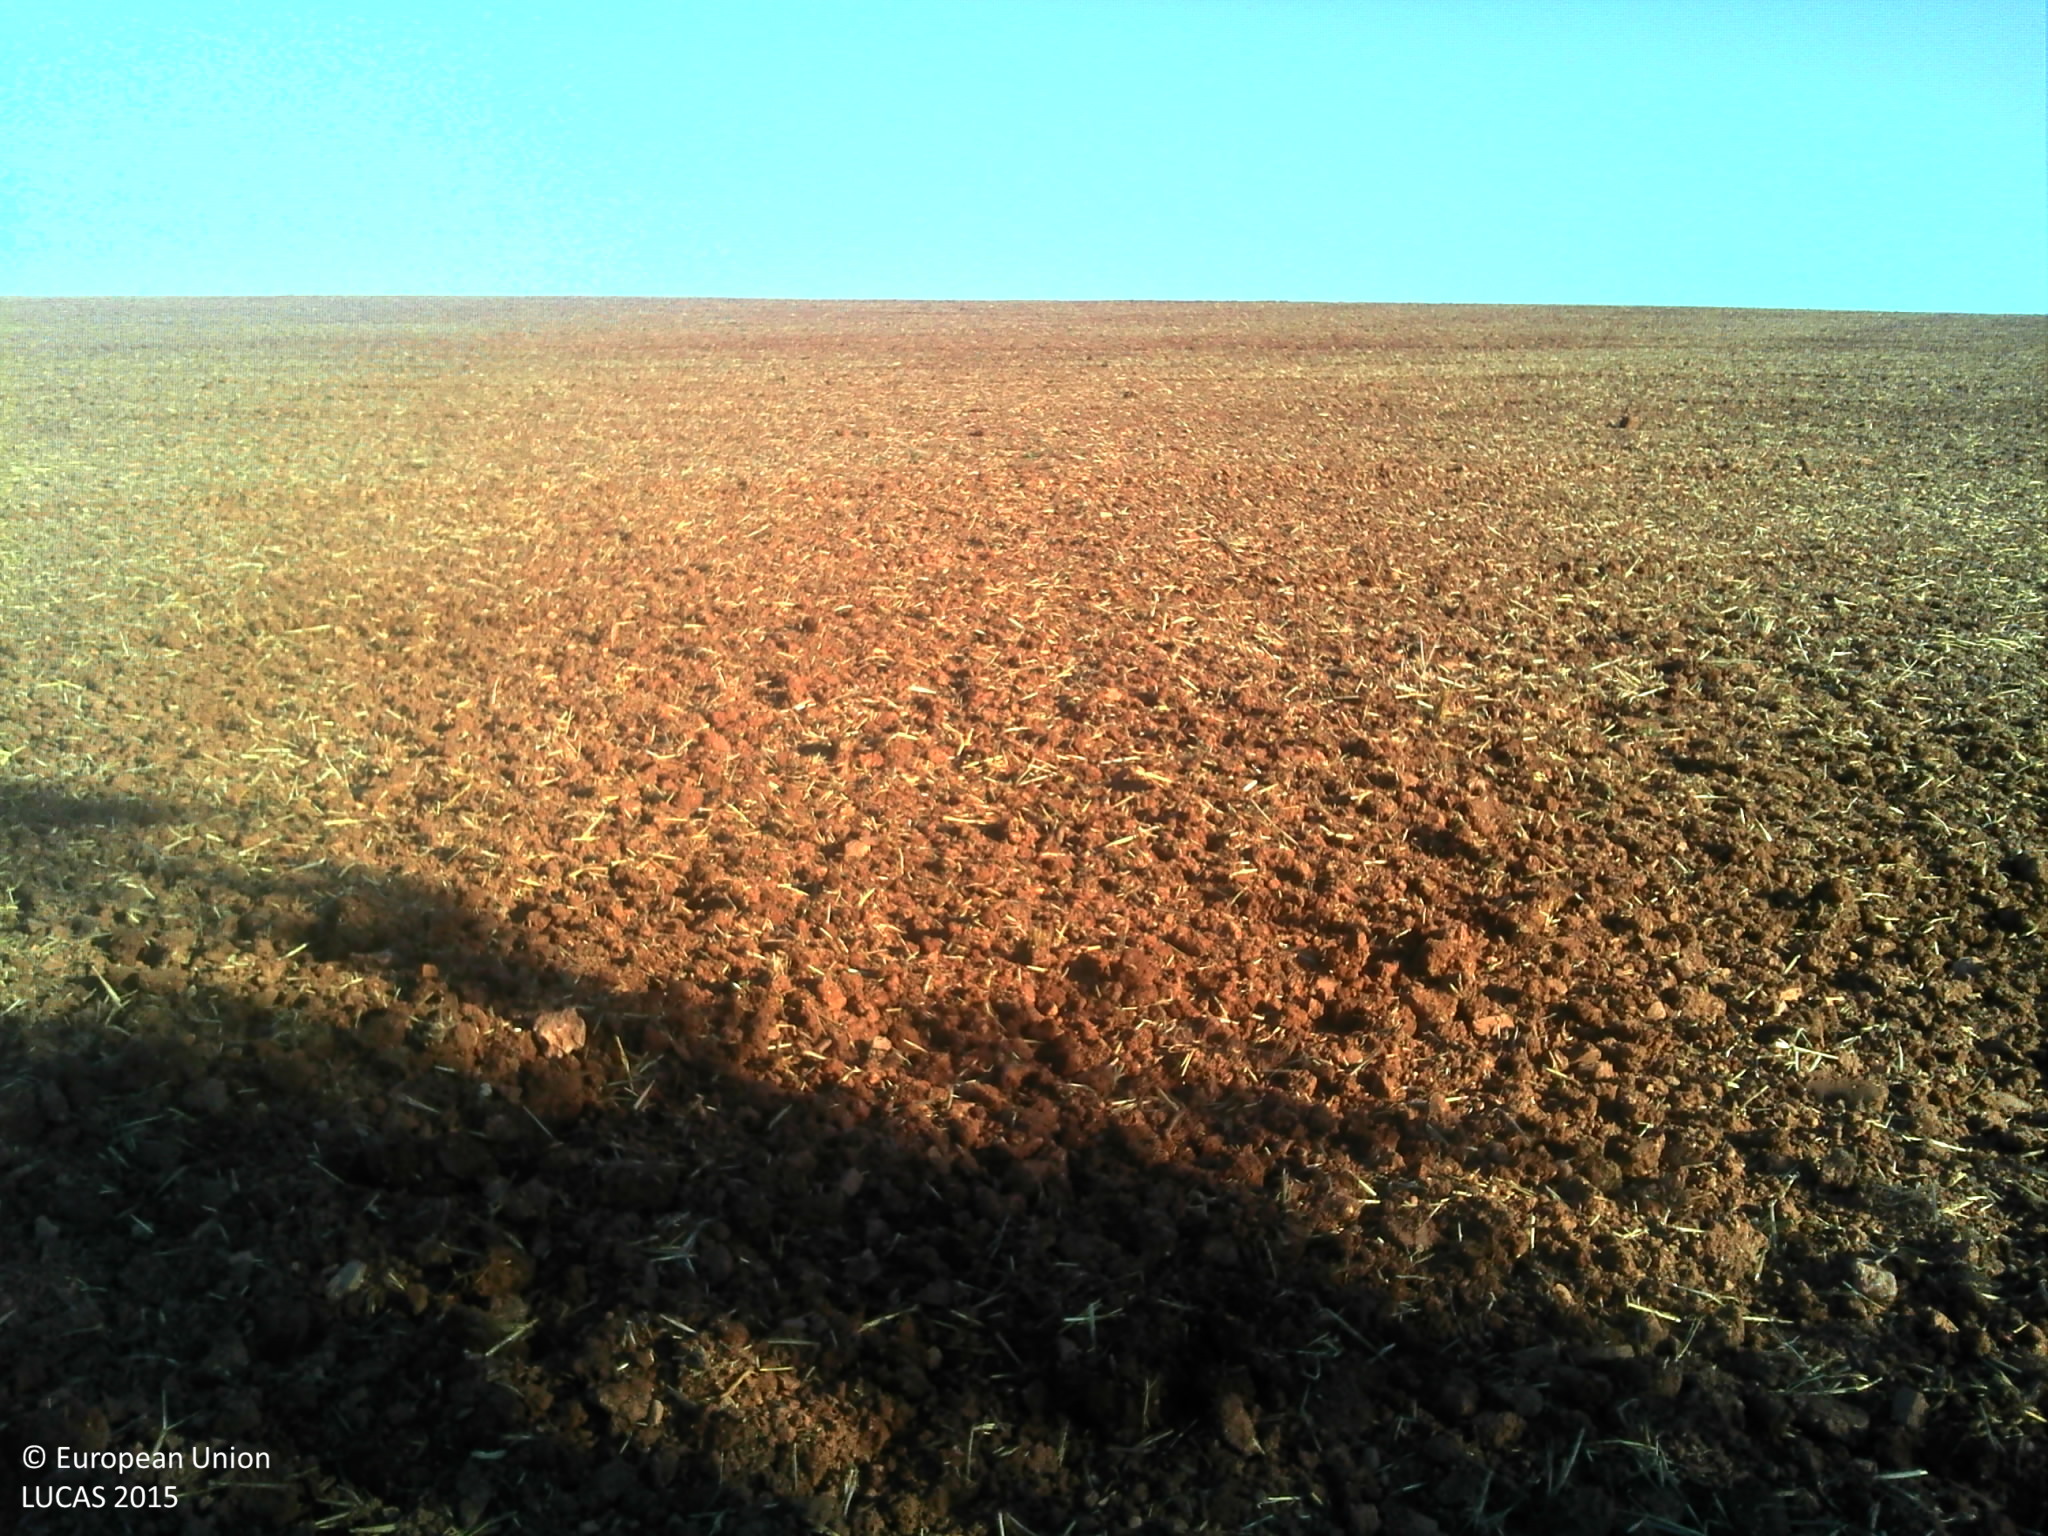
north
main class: Cropland
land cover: Common wheat
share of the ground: < 10 %
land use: Agriculture (excluding fallow land and kitchen gardens)
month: October
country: FR
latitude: 48.5389
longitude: 6.2756
